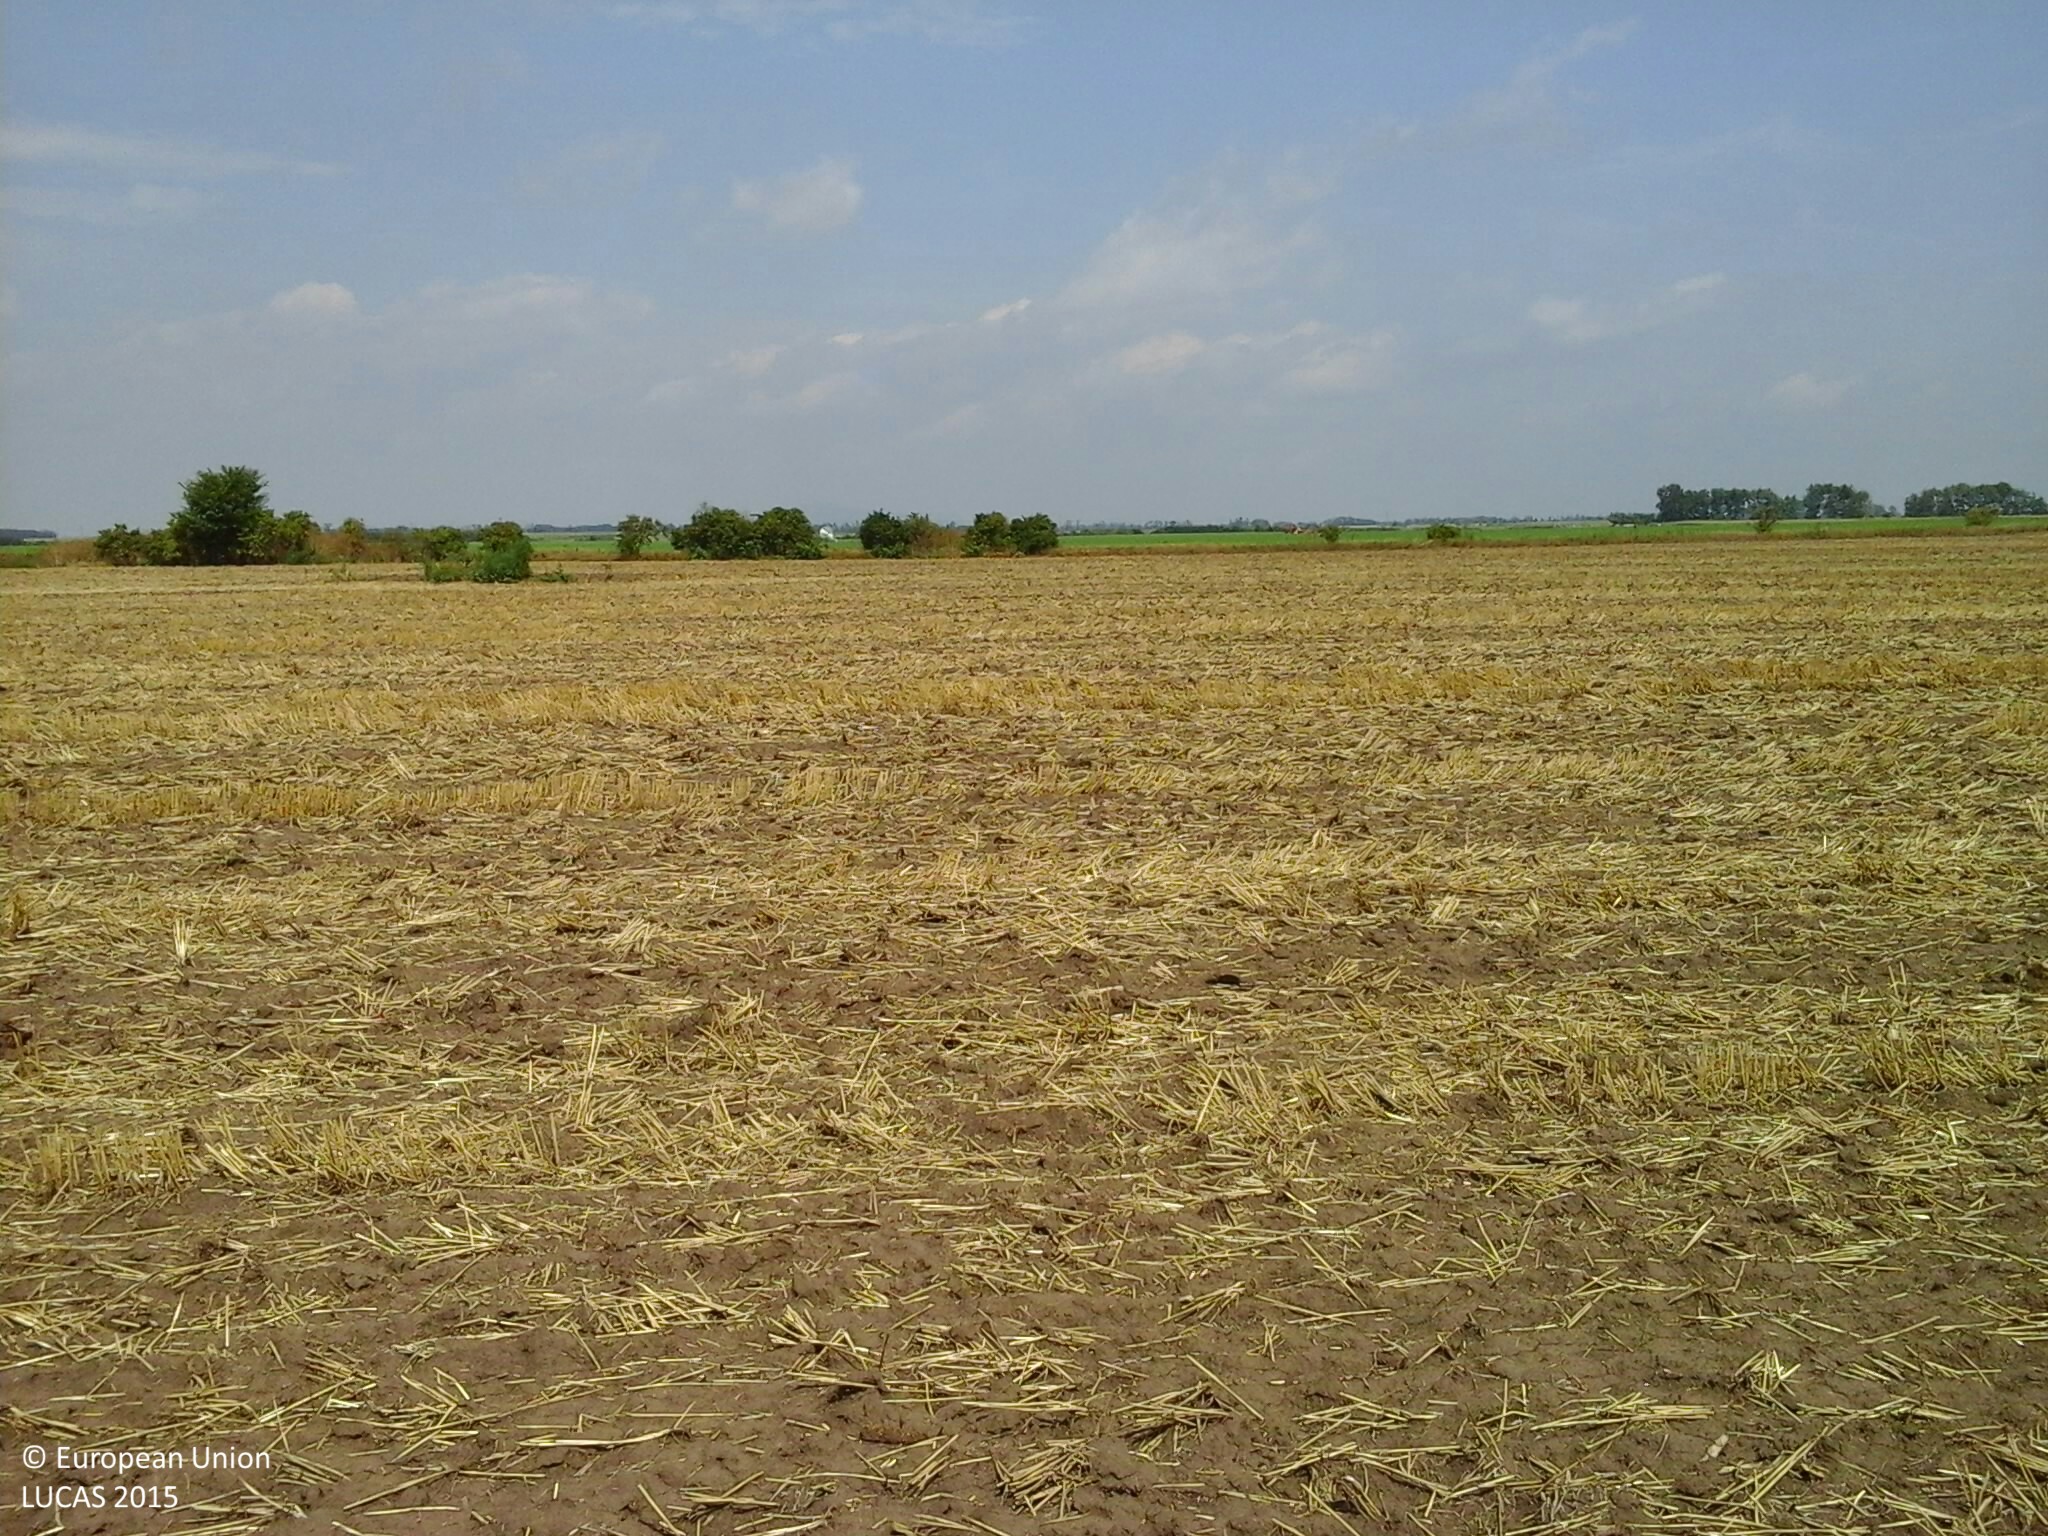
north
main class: Cropland
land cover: Common wheat
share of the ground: 10 - 25 %
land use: Agriculture (excluding fallow land and kitchen gardens)
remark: Harvested field
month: July
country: HU
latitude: 47.8997
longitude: 21.4274
